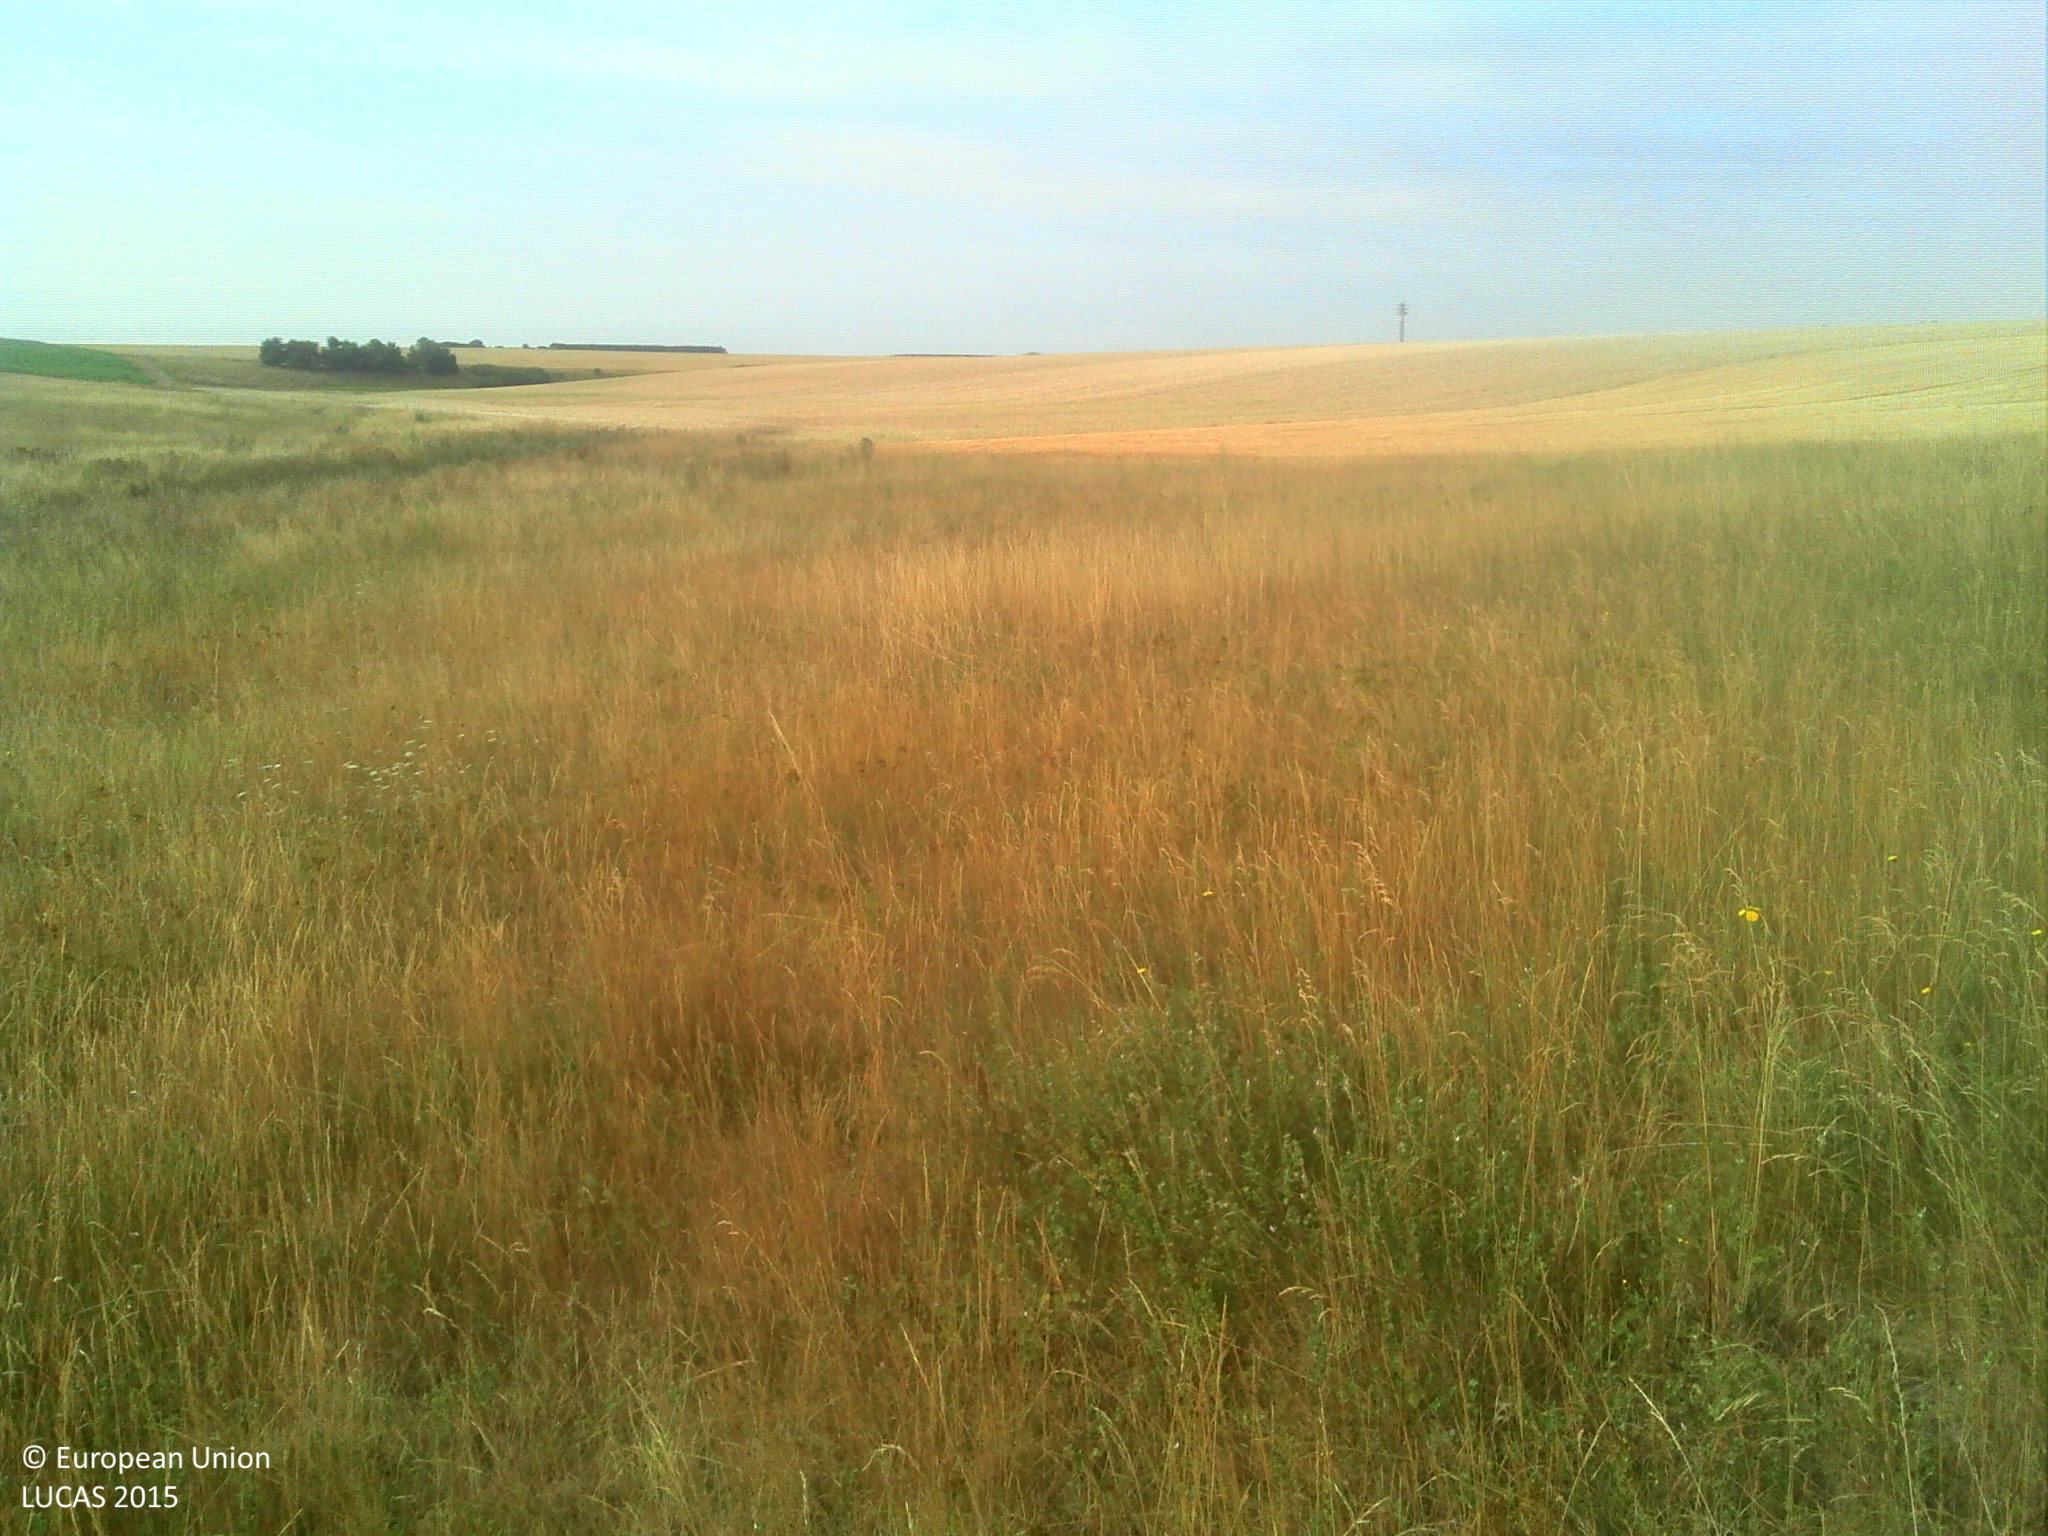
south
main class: Grassland
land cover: Grassland without tree/shrub cover
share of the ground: > 75 %
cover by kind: herbaceous plants 100 %
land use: Agriculture (excluding fallow land and kitchen gardens)
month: July
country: FR
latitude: 47.7923
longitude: 1.3471
